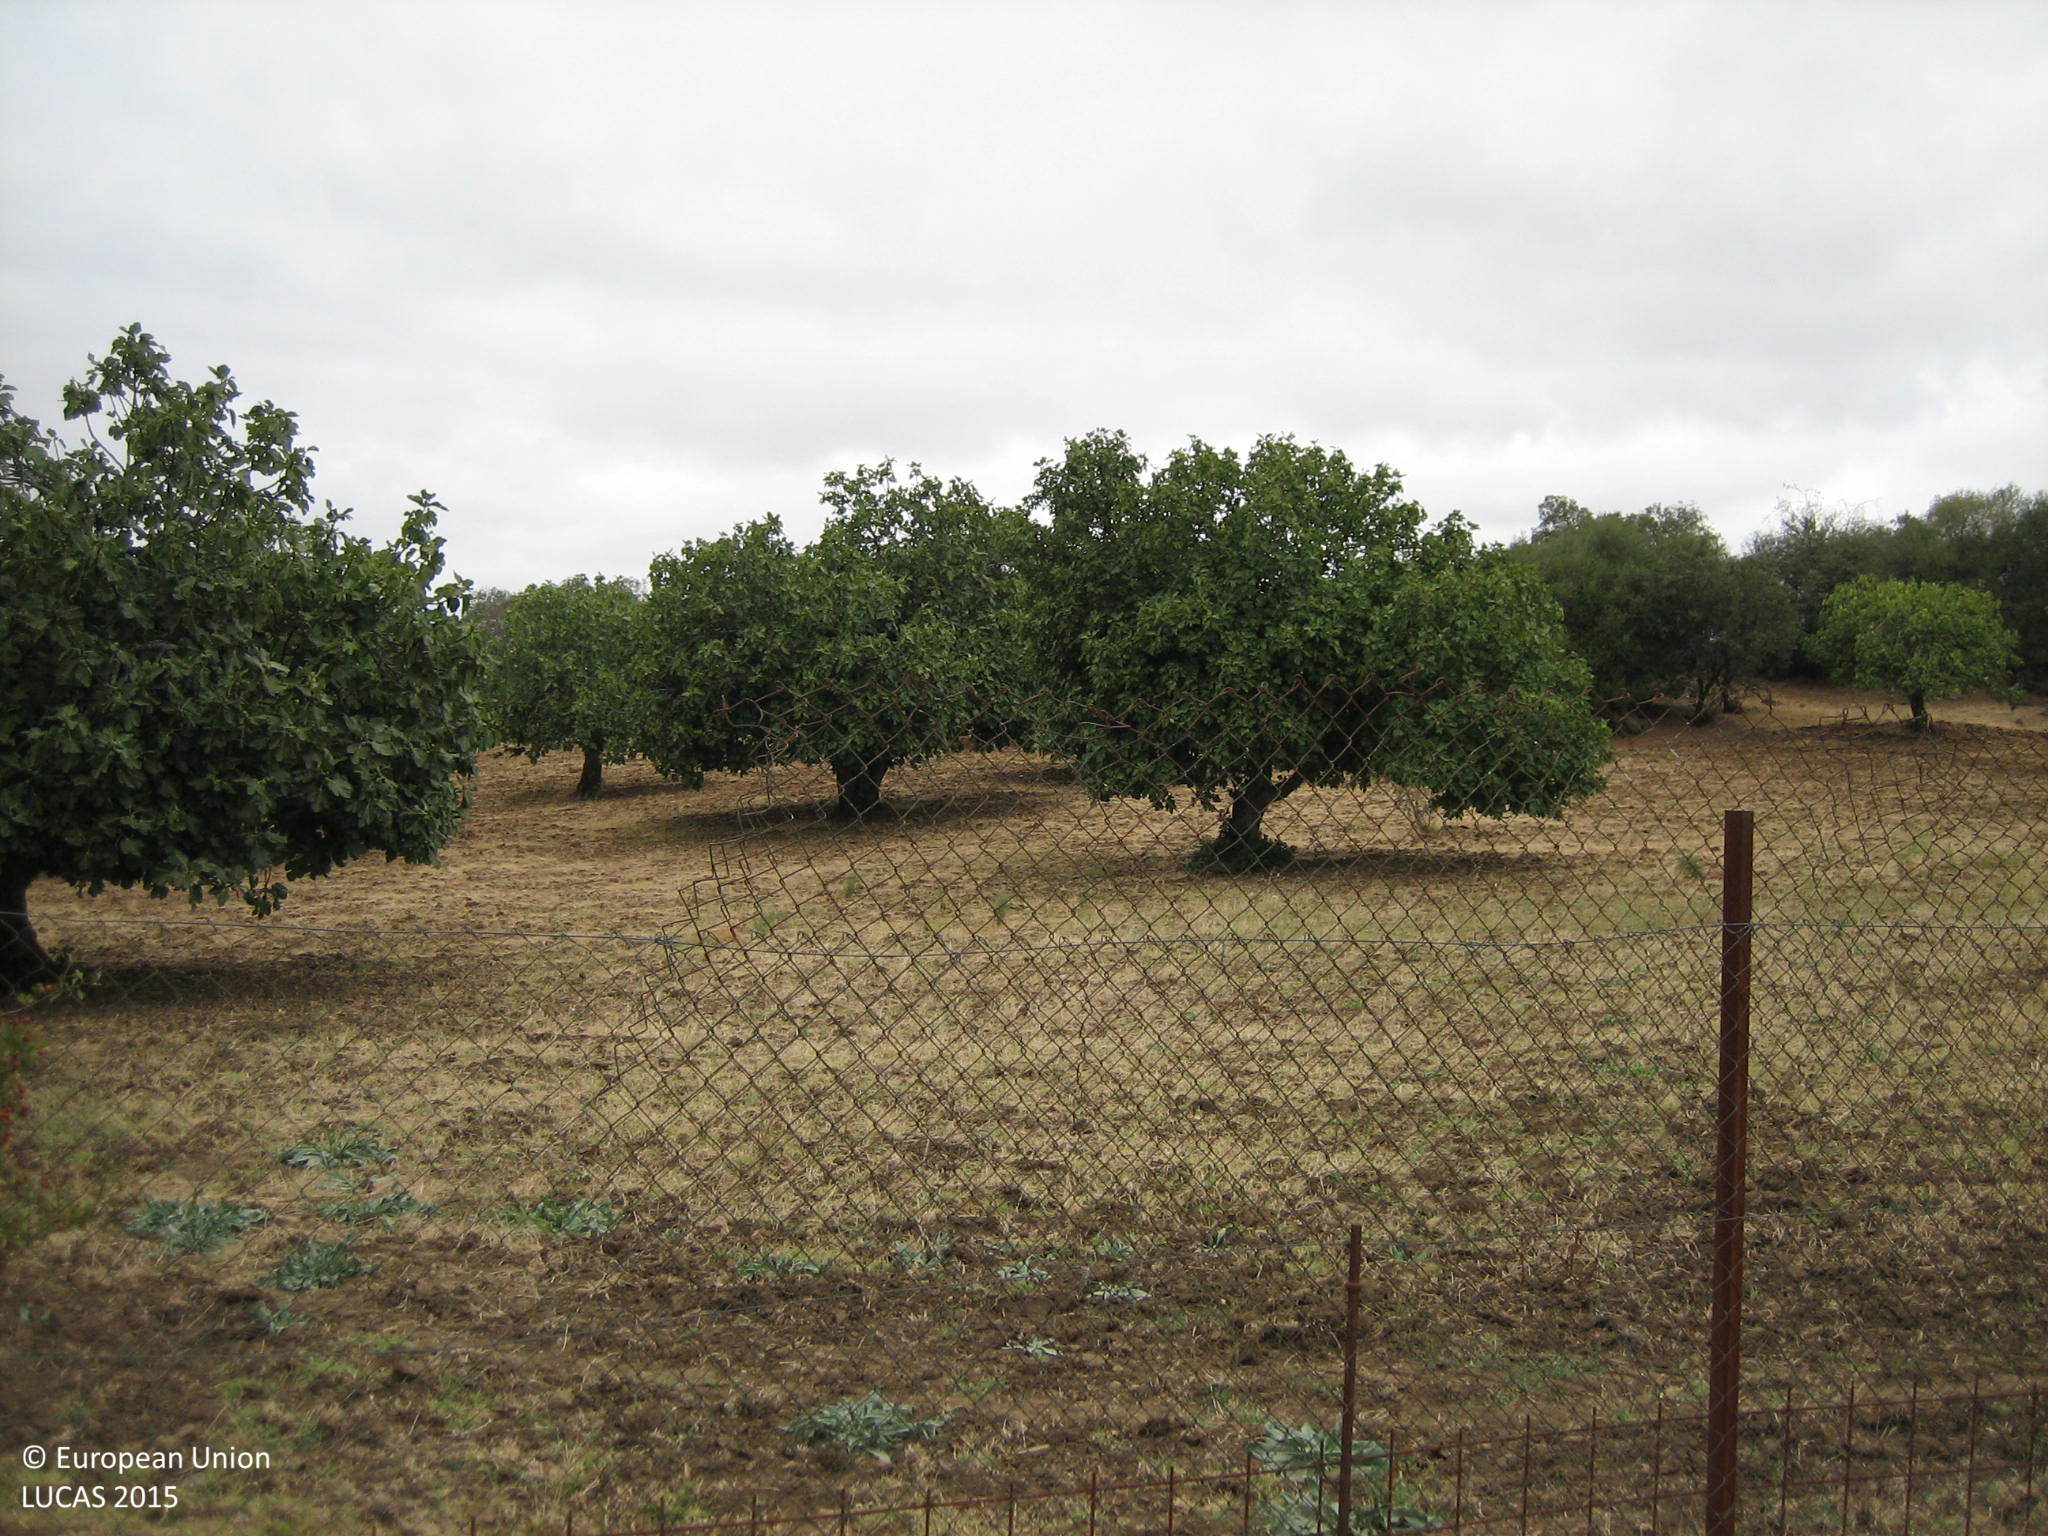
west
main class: Cropland
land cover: Other fruit trees and berries
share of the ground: 25 - 50 %
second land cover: Spontaneously vegetated surfaces
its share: 10 - 25 %
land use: Agriculture (excluding fallow land and kitchen gardens)
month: September
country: ES
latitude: 38.5190
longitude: -6.8636
